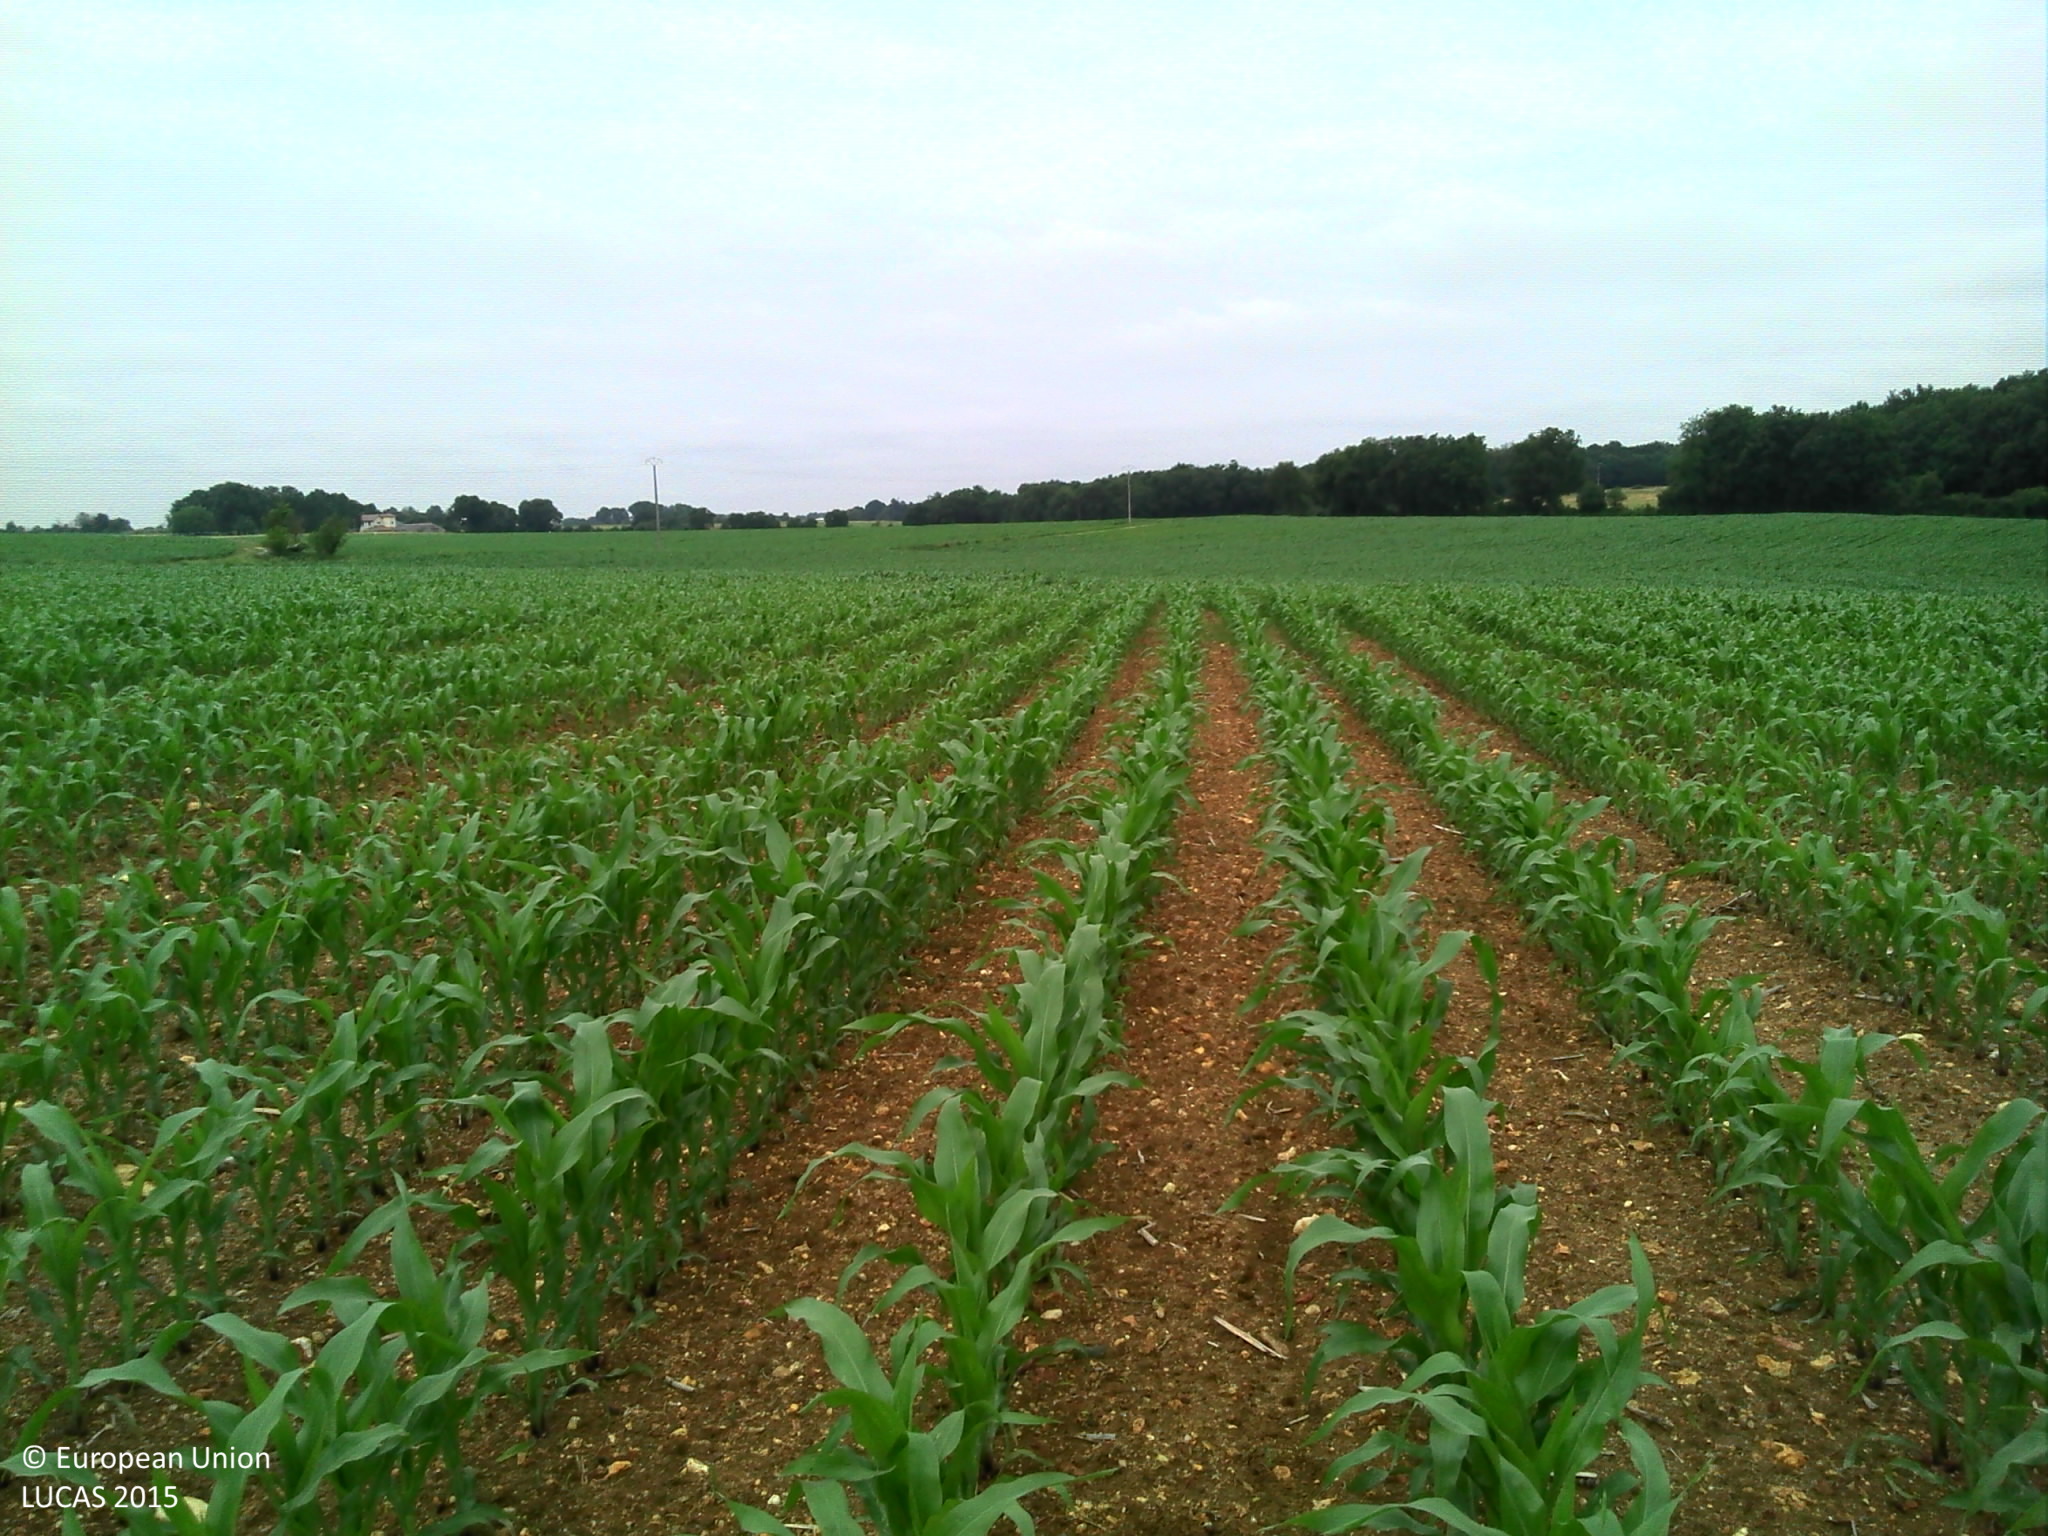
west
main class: Cropland
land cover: Maize
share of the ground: 50 - 75 %
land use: Agriculture (excluding fallow land and kitchen gardens)
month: June
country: FR
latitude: 46.4928
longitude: 0.5372
